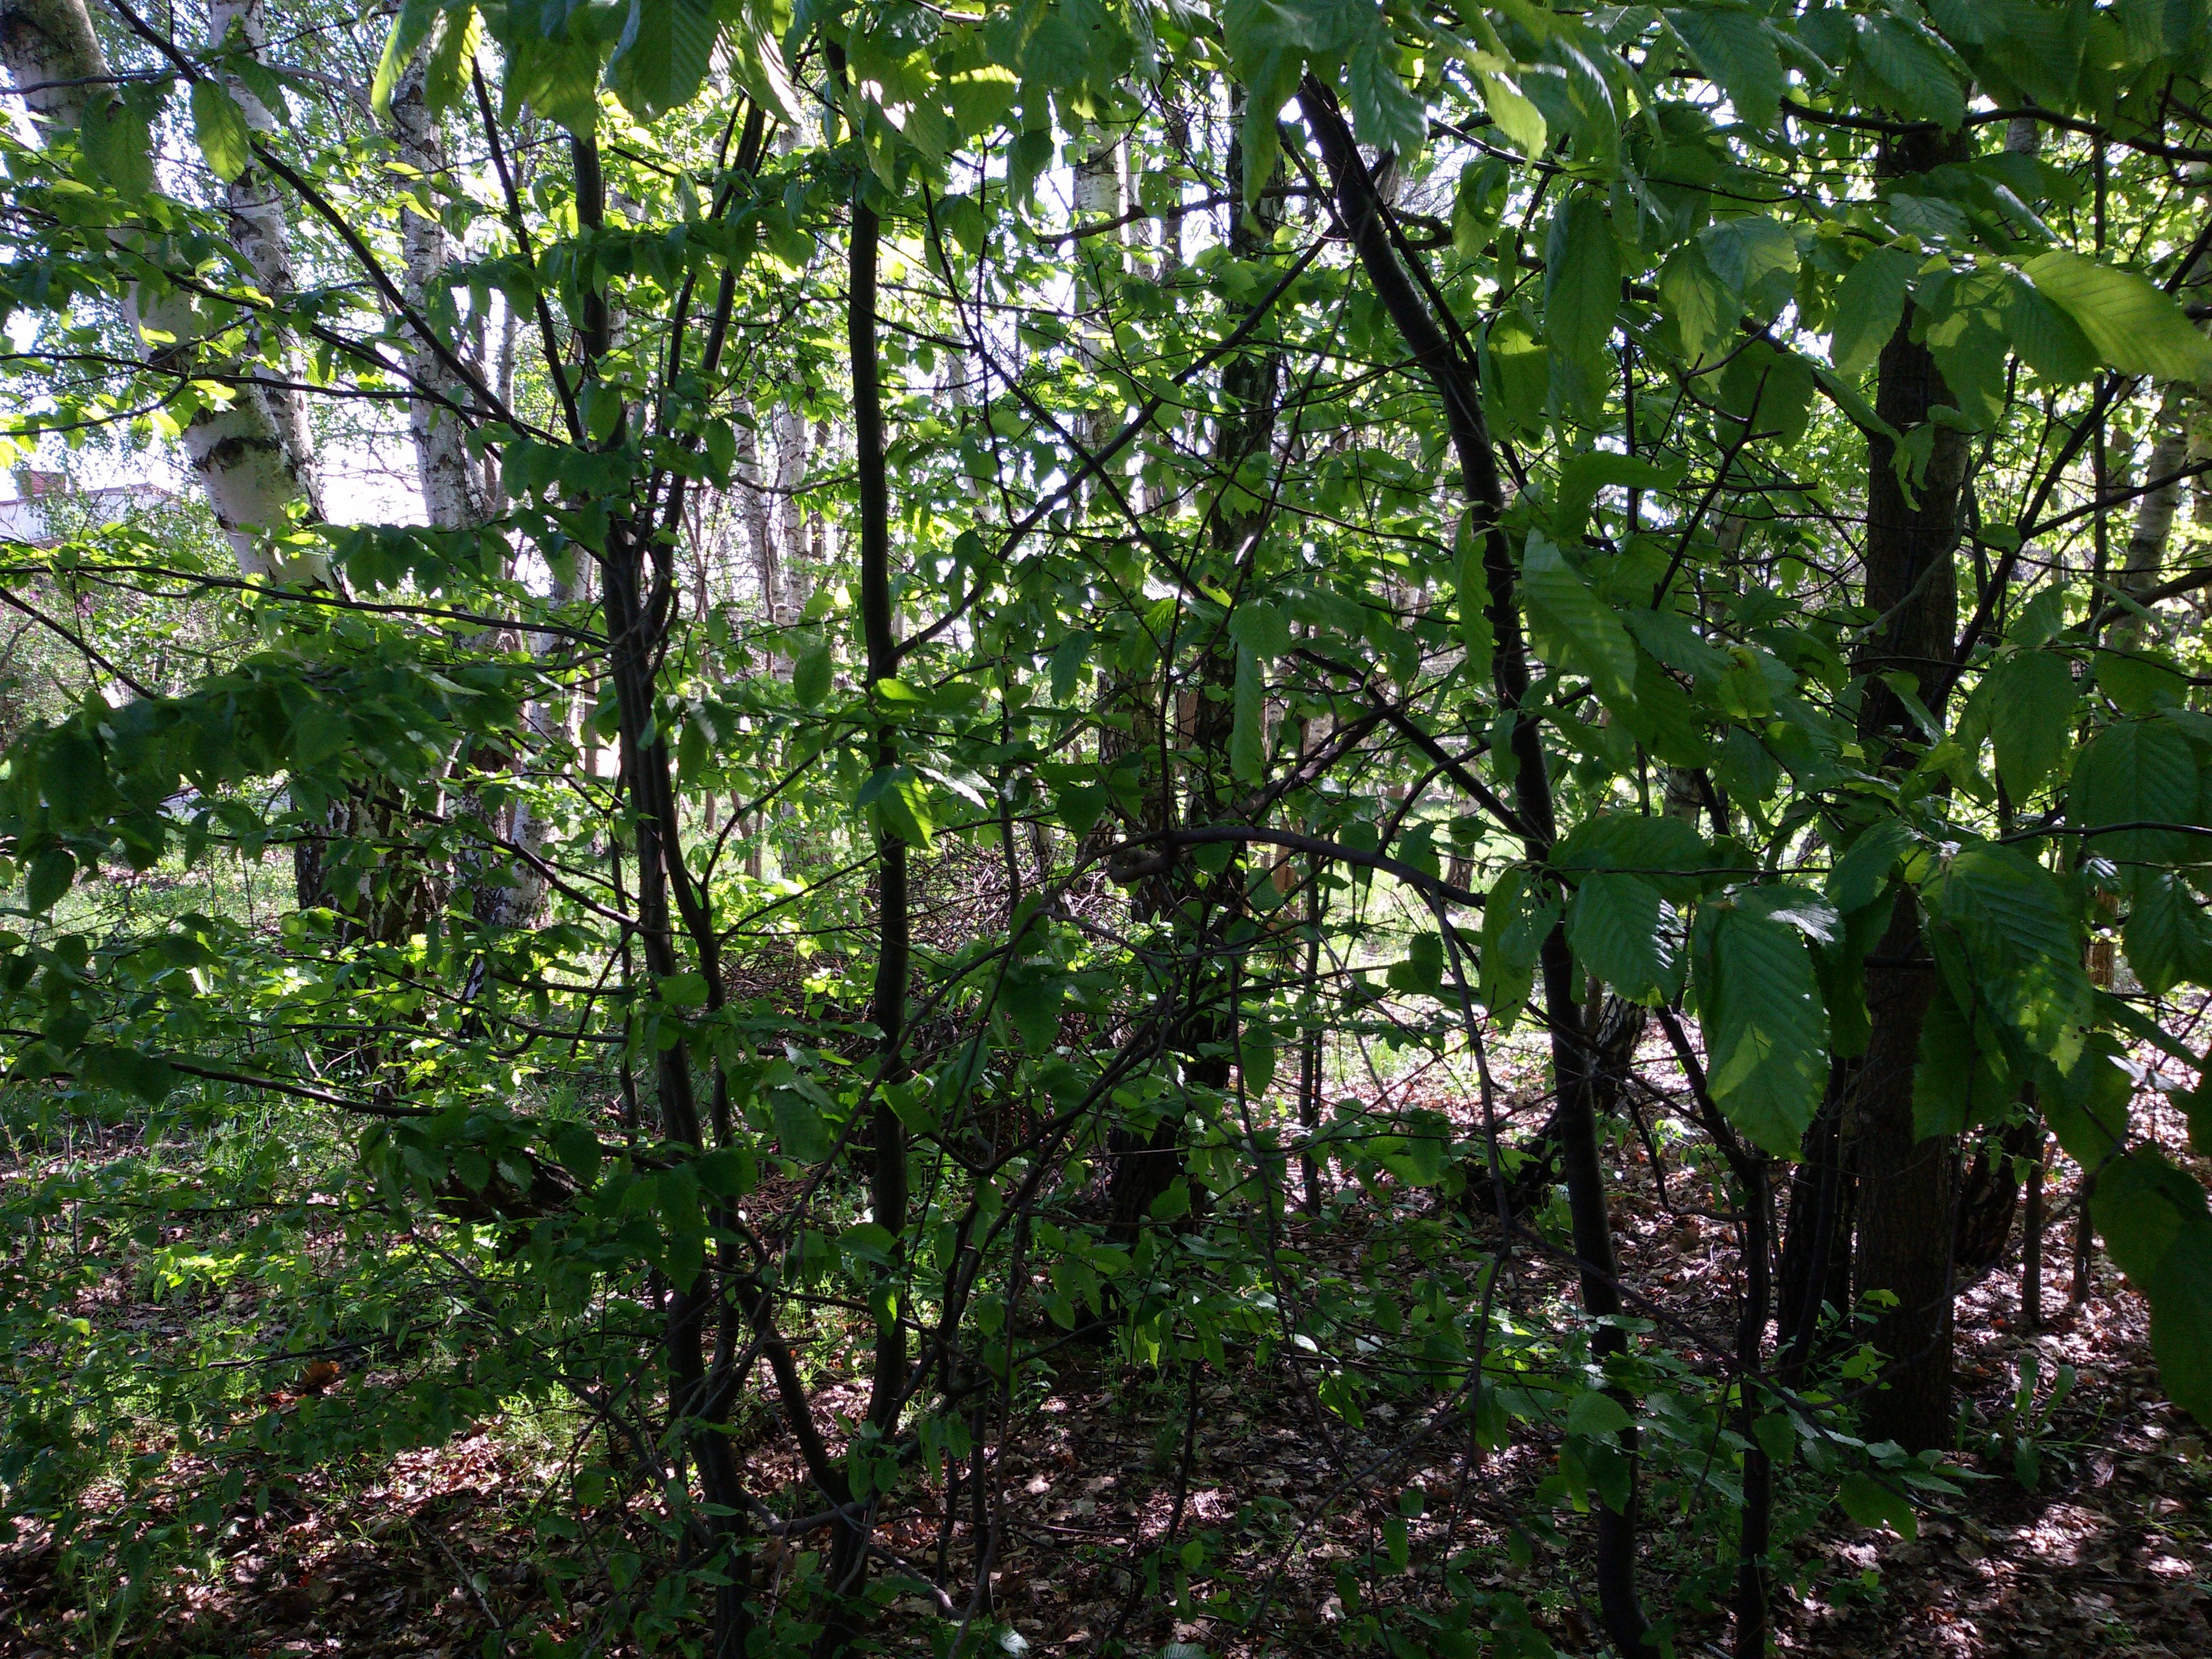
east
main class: Woodland
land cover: Broadleaved woodland
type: mesophytic deciduous forest
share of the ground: > 75 %
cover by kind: broadleaved forest trees 100 %
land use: Forestry
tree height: > 5 m
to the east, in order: Broadleaved woodland; Artificial constructions in urban areas
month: May
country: PL
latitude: 52.0101
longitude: 23.1166
